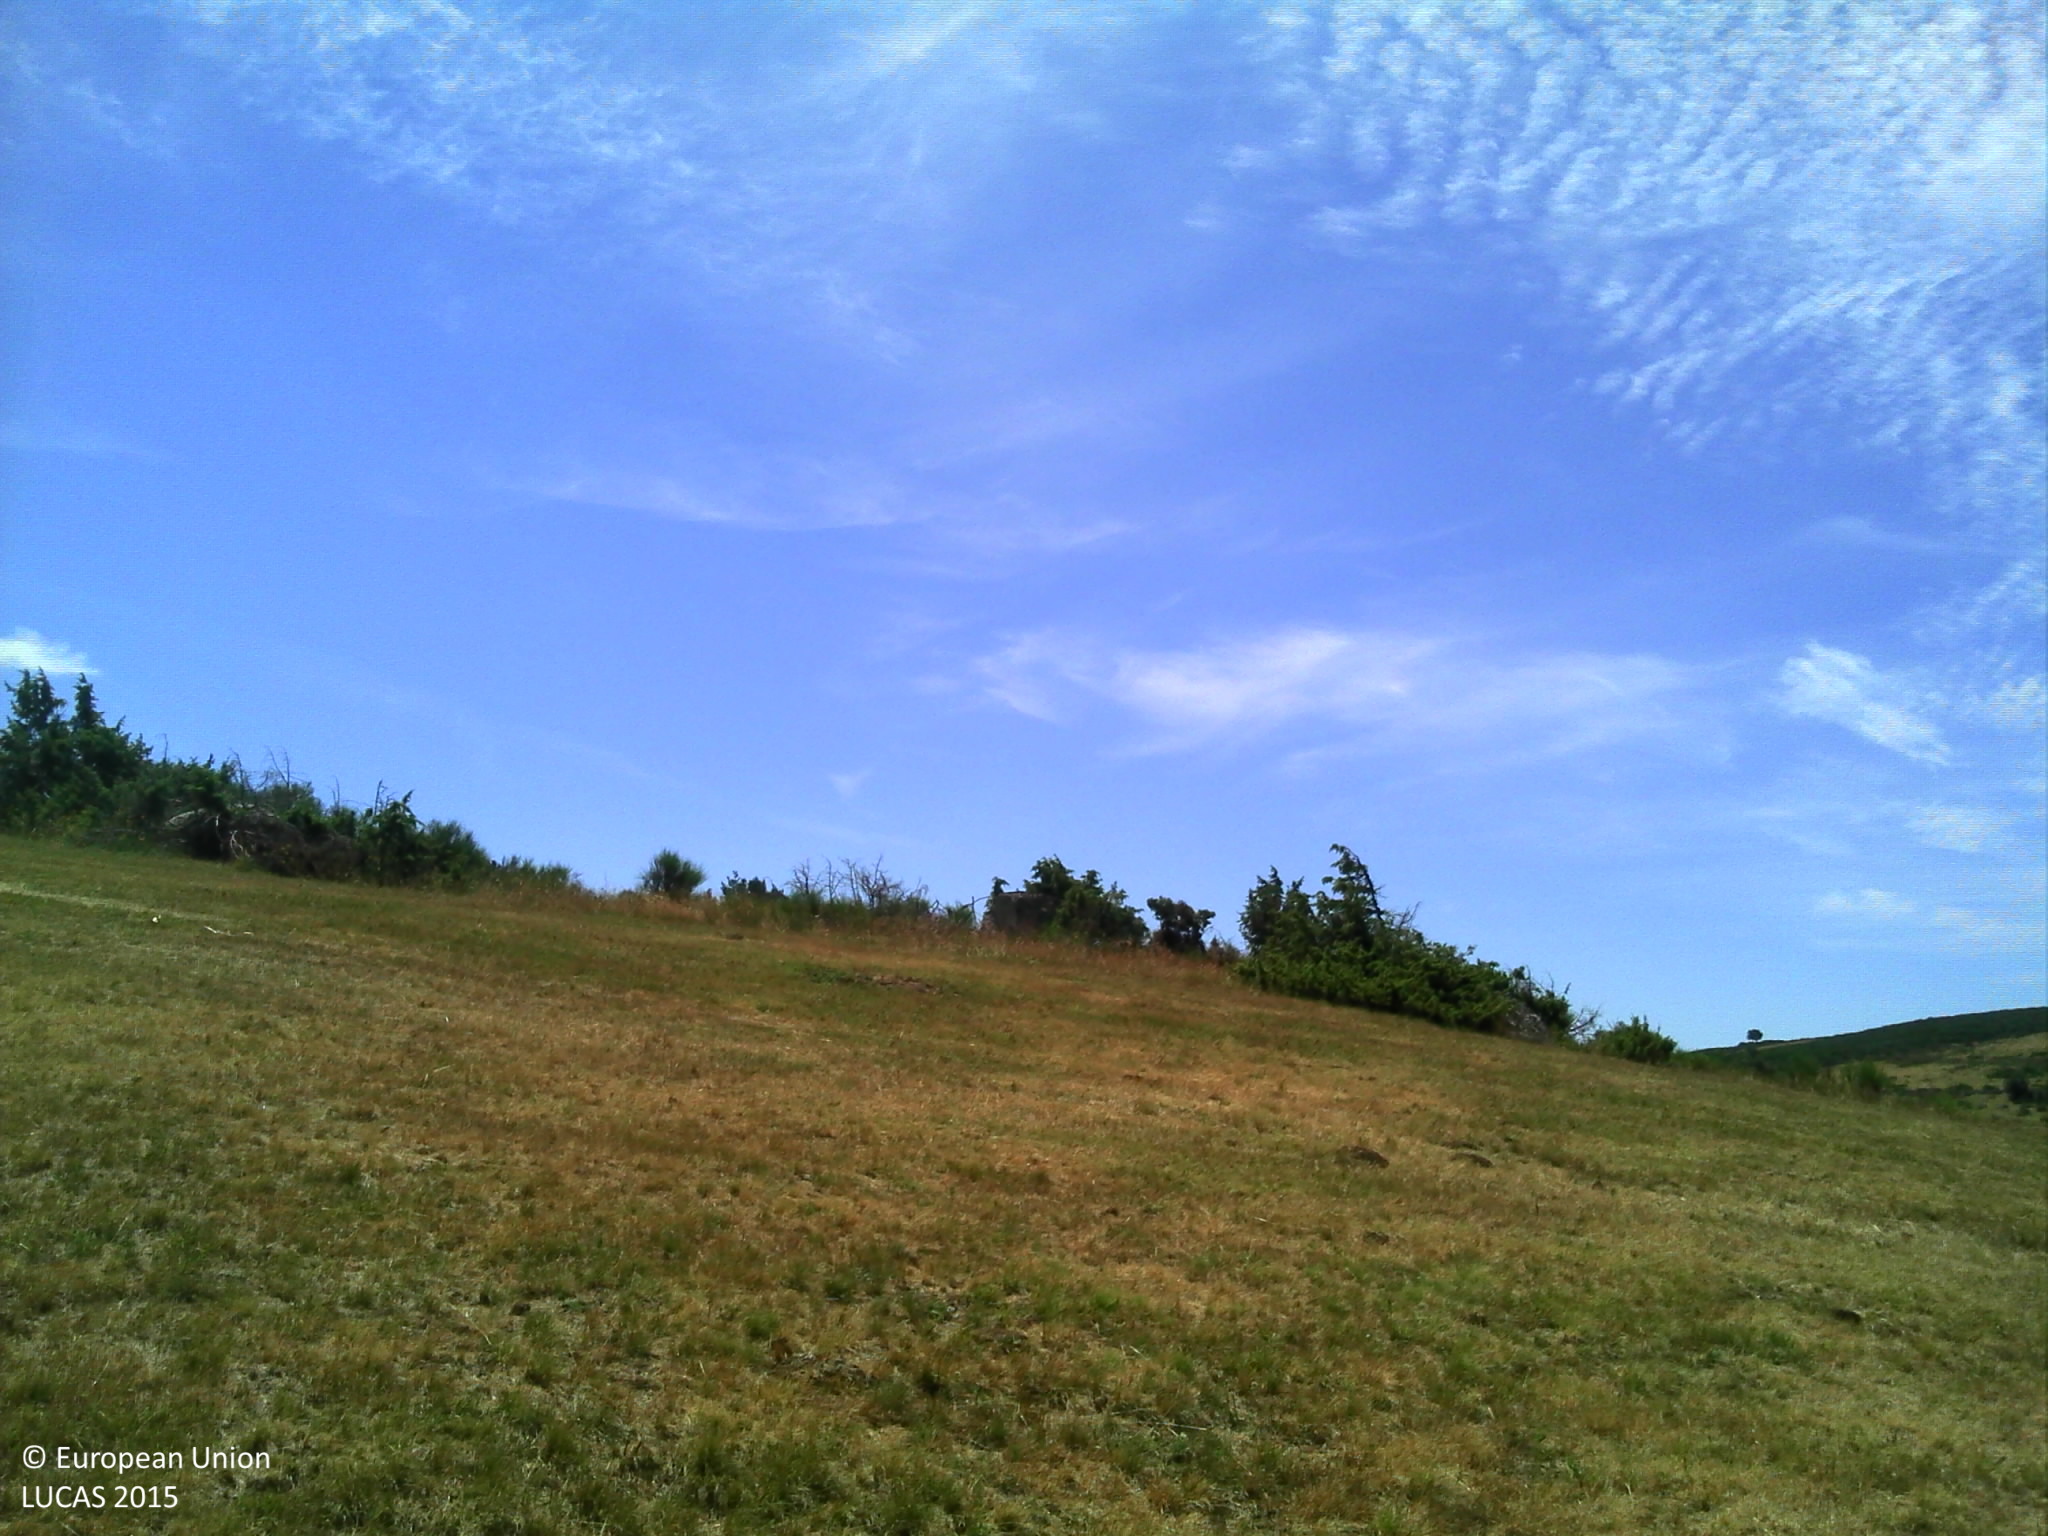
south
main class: Grassland
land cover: Grassland without tree/shrub cover
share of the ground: > 75 %
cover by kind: herbaceous plants 100 %
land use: Agriculture (excluding fallow land and kitchen gardens)
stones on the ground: 10 - 25 %
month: July
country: FR
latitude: 44.6868
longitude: 3.1778
